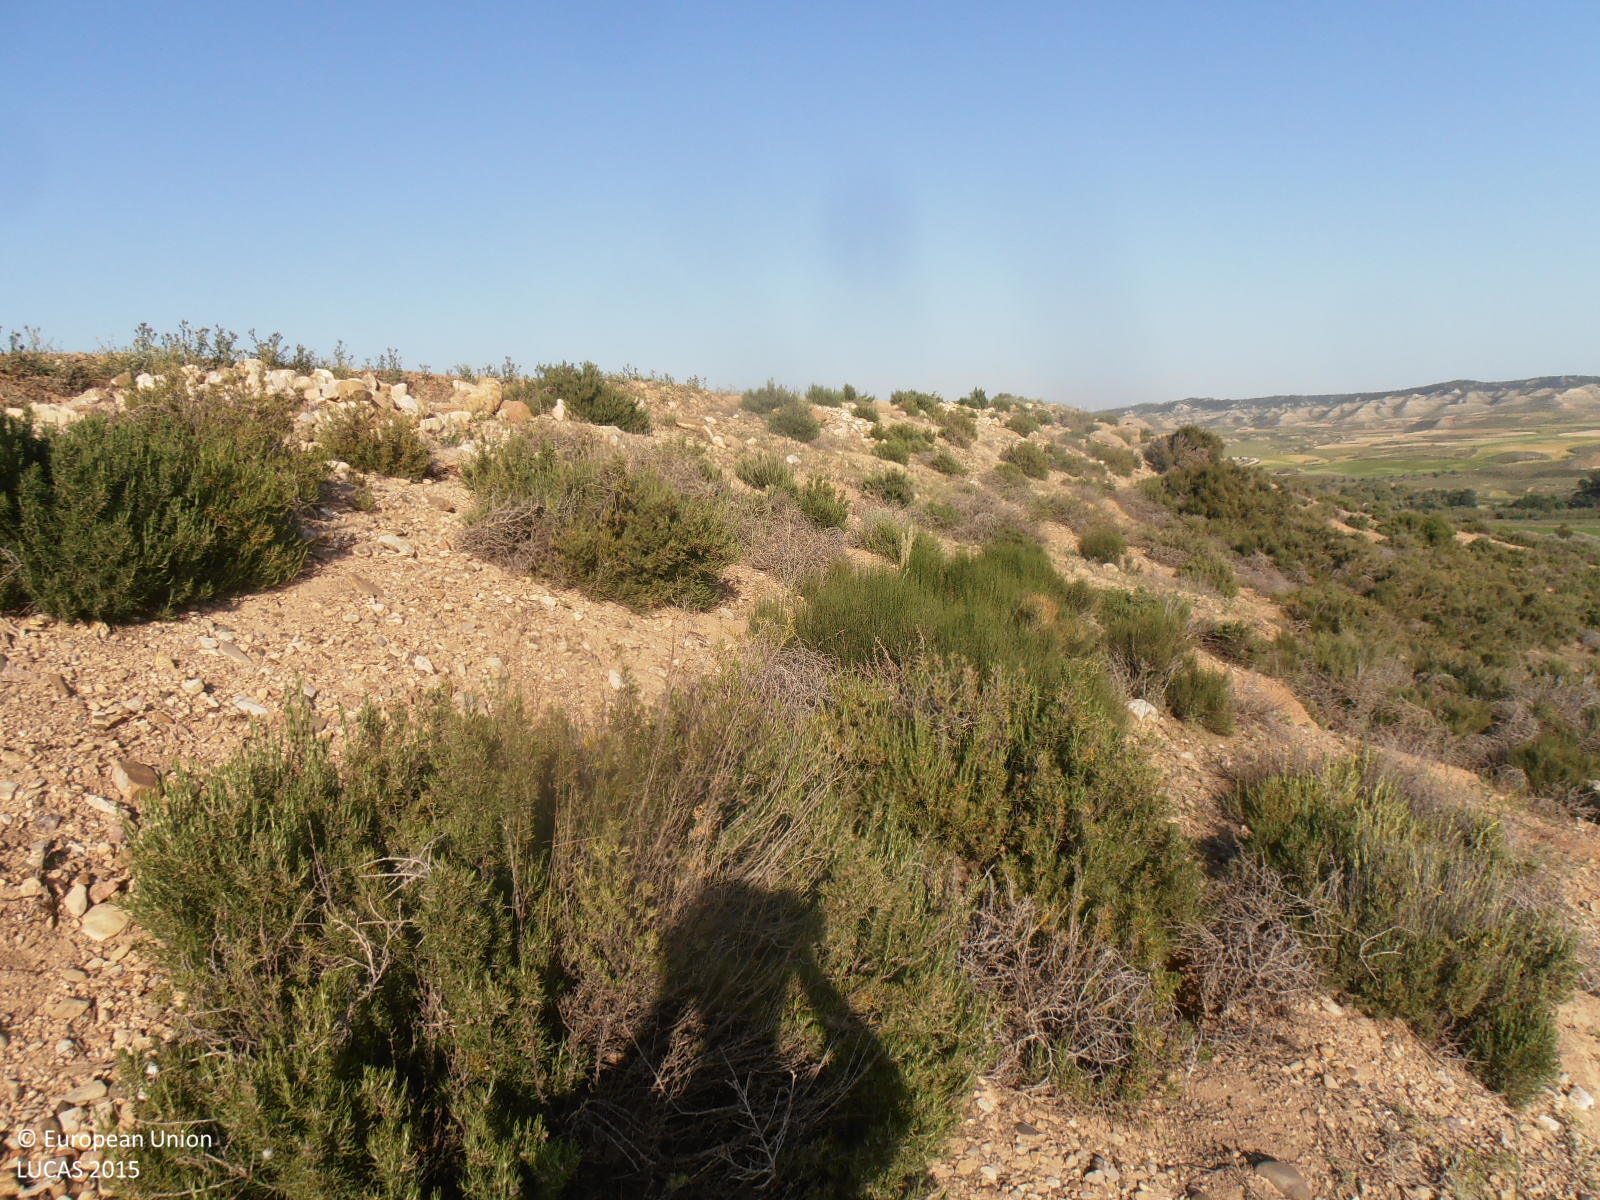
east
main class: Shrubland
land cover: Shrubland without tree cover
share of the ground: 25 - 50 %
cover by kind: consolidated bare surface 50 %, shrubs 40 %, unconsolidated bare surface 10 %
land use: Semi-natural and natural areas not in use
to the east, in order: Shrubland without tree cover; Other bare soil; Shrubland without tree cover; Fences; Shrubland without tree cover; Ditches and canals; Shruby margins; Paved roads, cycling and walking lanes; Shruby margins; Artificial constructions; Shruby margins; Paved roads, cycling and walking lanes; Other bare soil; Fences; Shrubland without tree cover
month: May
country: ES
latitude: 41.5210
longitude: -1.0344
